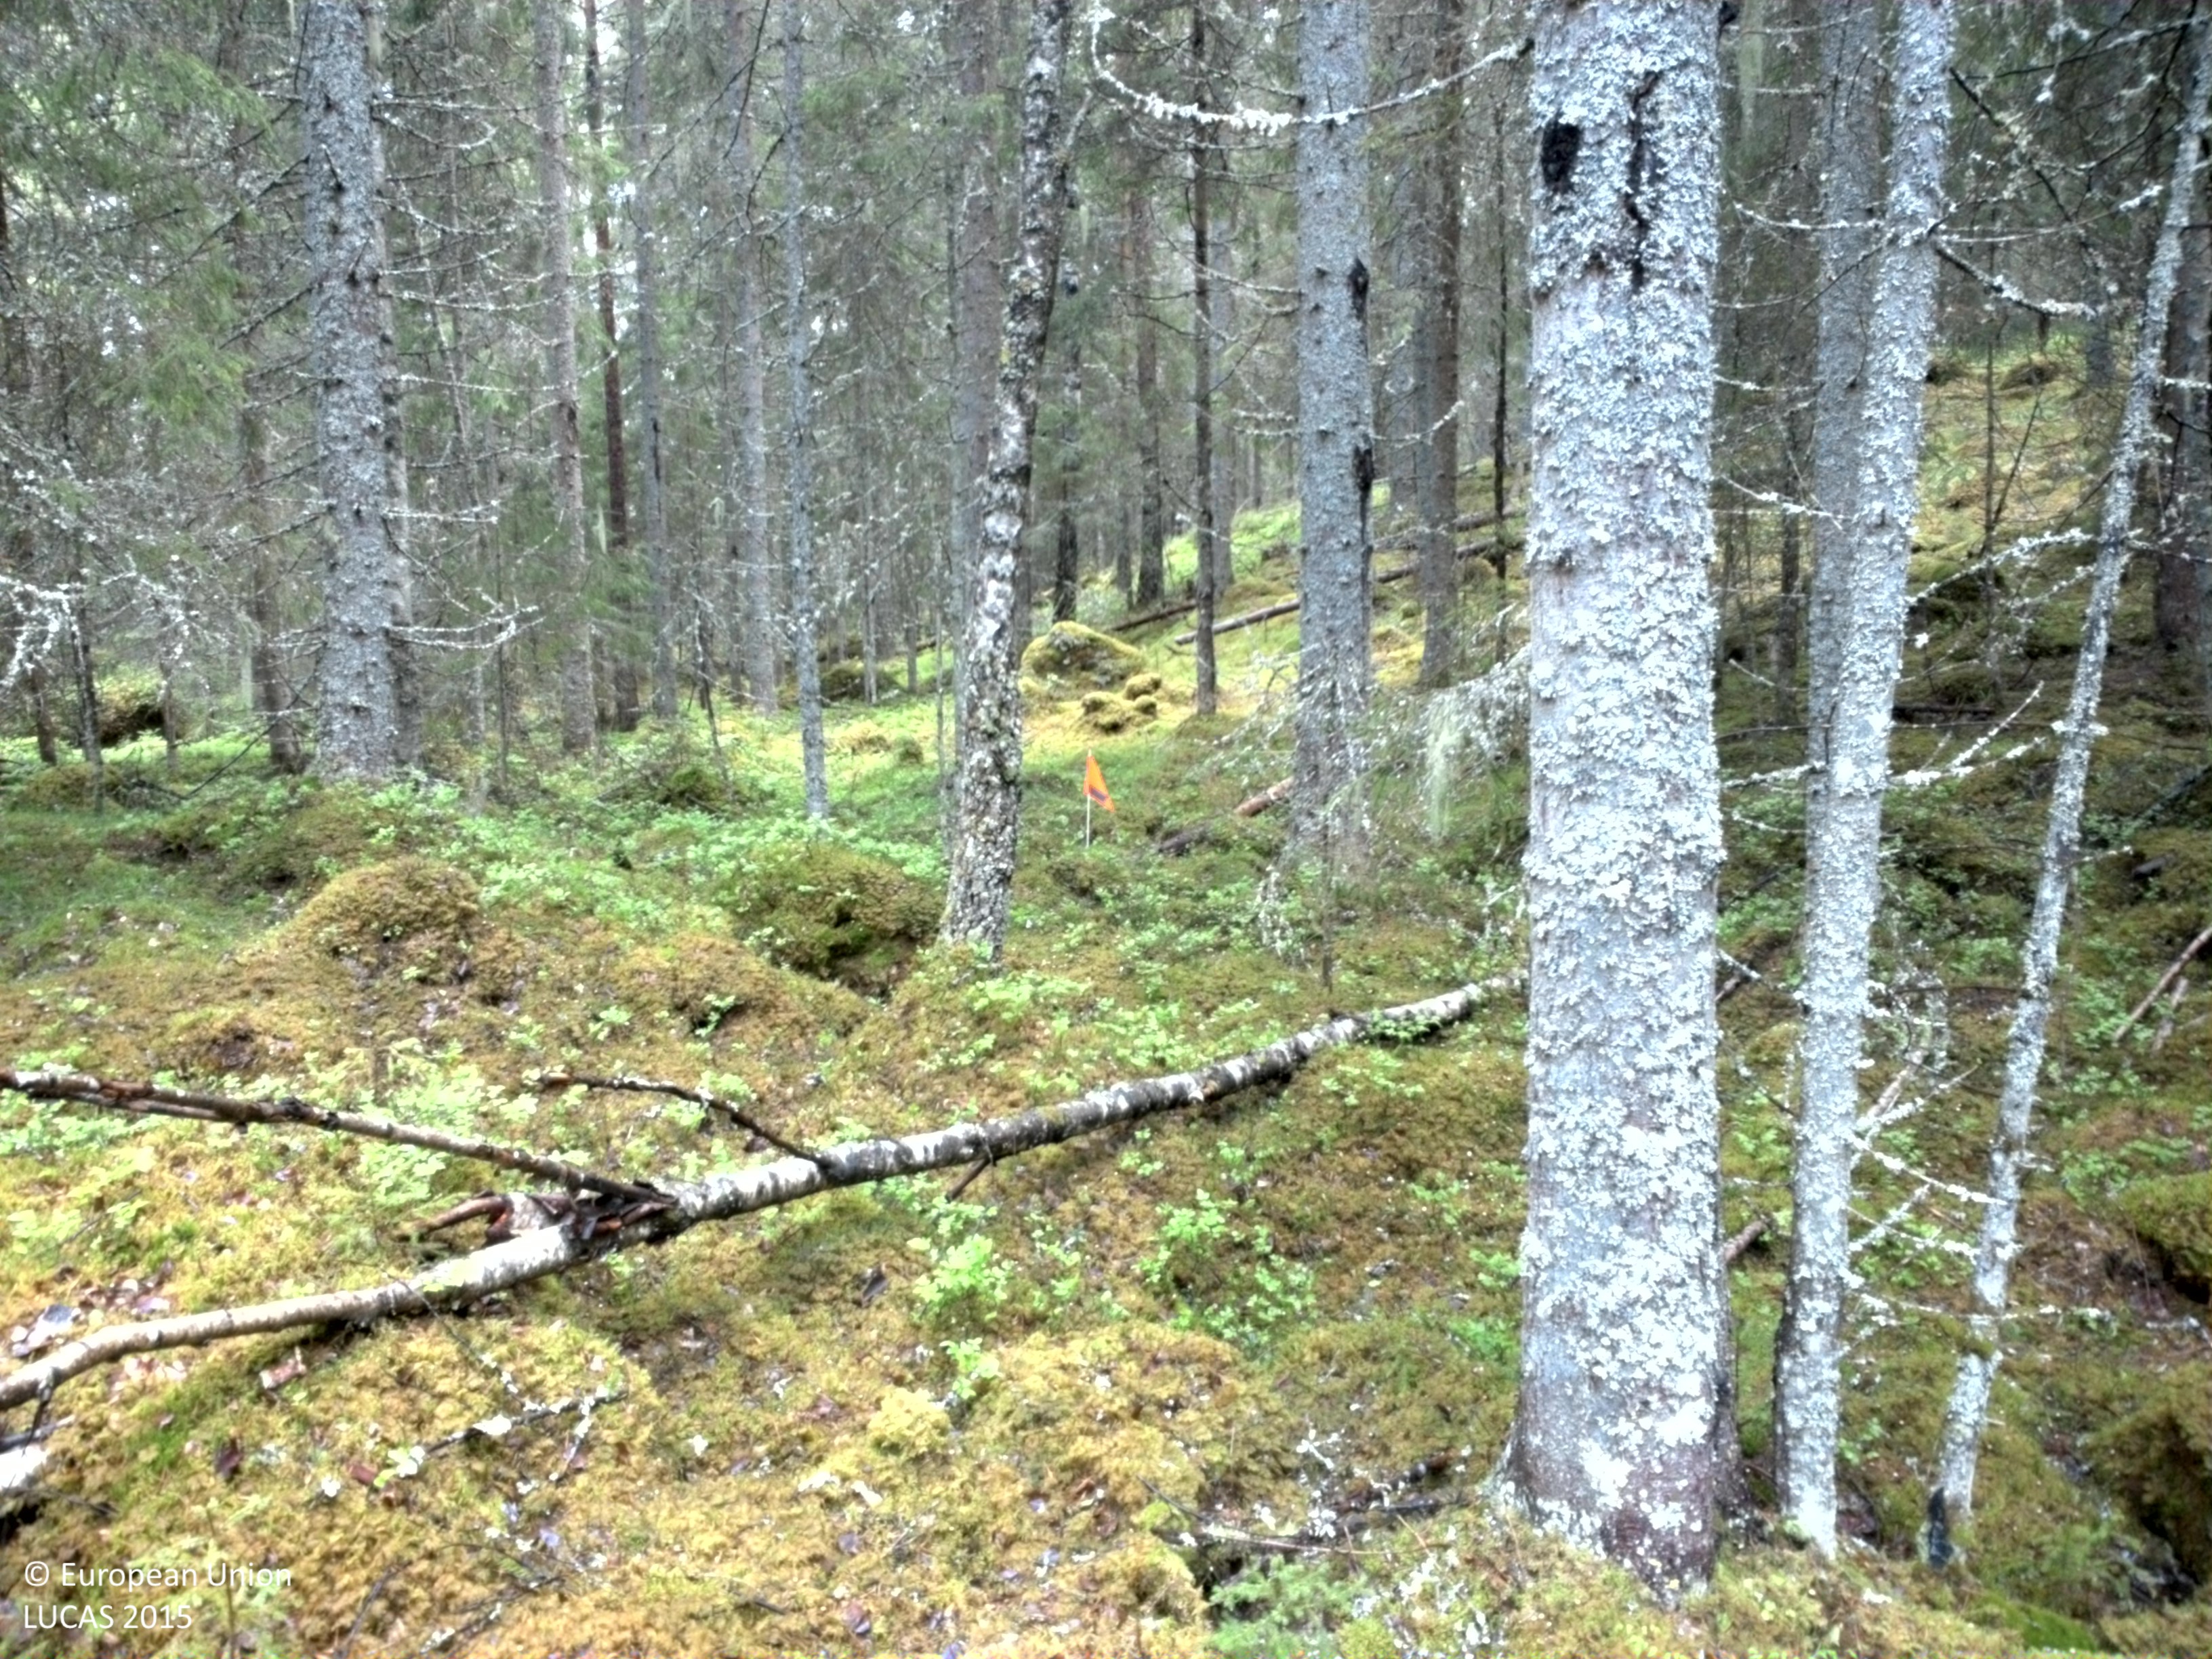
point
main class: Woodland
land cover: Spruce dominated coniferous woodland
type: boreal forest
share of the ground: 50 - 75 %
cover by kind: coniferous forest trees 60 %, lichens and mosses 25 %, shrubs 10 %, broadleaved forest trees 5 %
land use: Forestry
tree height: > 5 m
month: June
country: SE
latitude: 60.2707
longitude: 13.1906
